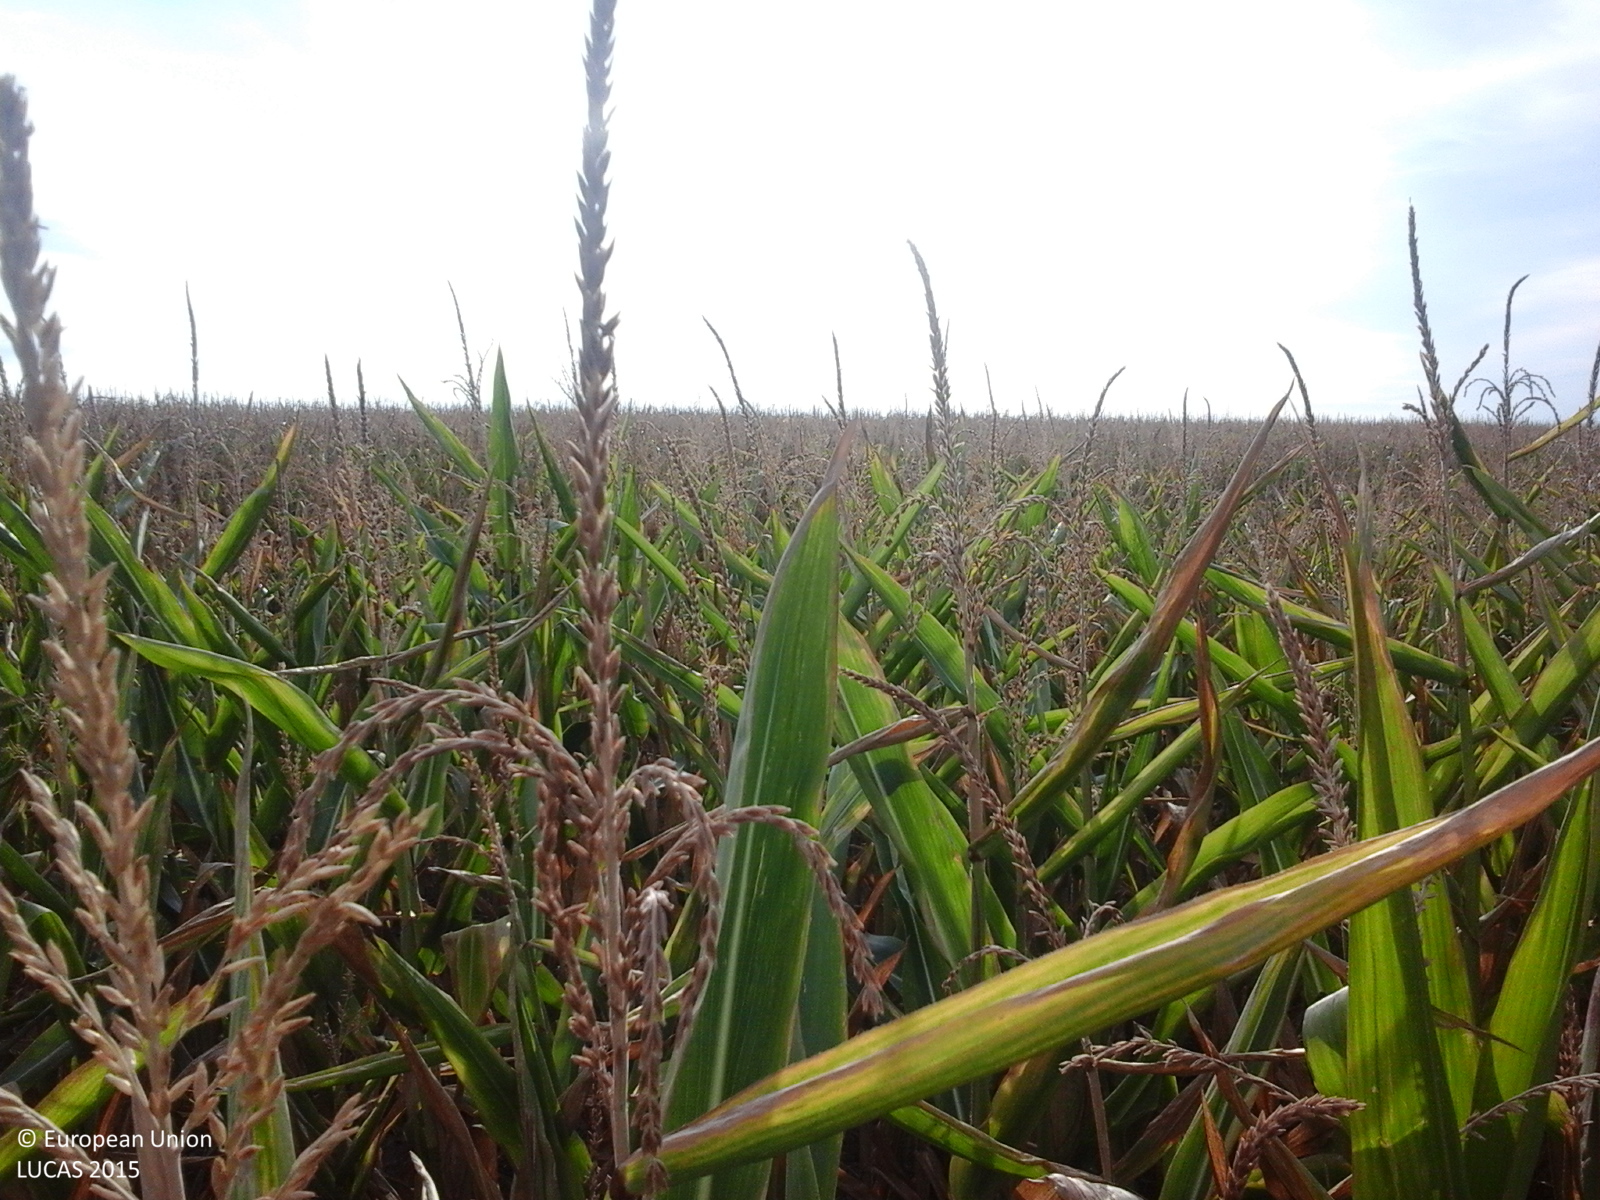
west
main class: Cropland
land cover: Maize
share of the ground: > 75 %
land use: Agriculture (excluding fallow land and kitchen gardens)
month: August
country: RO
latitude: 45.0478
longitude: 21.5714
